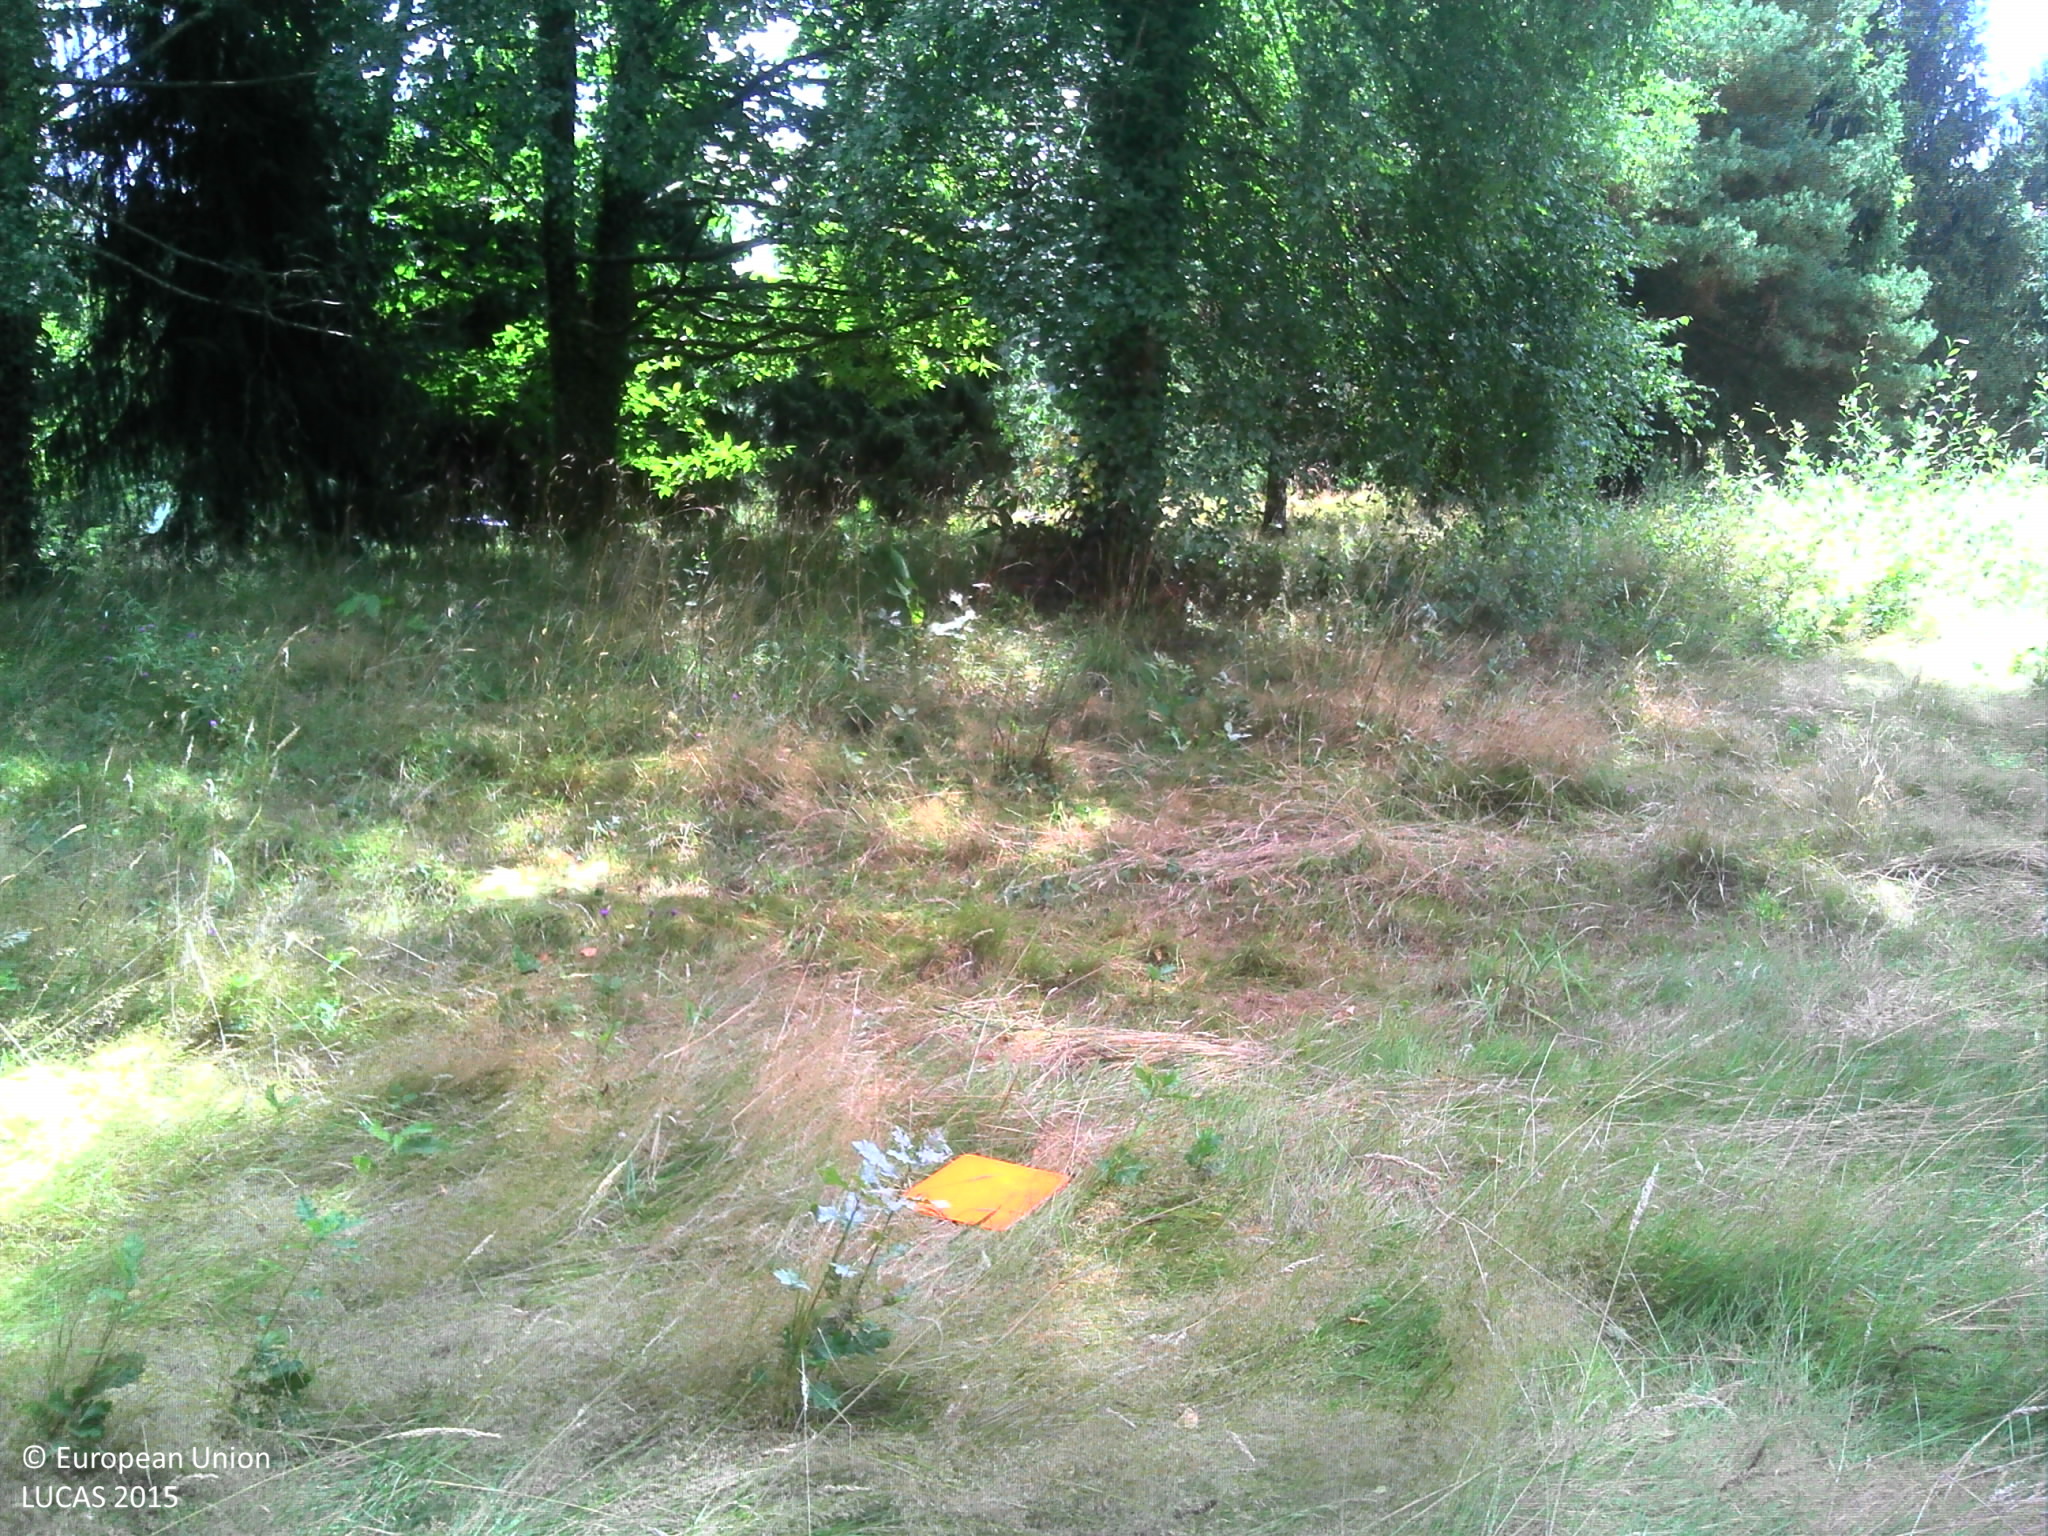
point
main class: Grassland
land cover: Grassland with sparse tree/shrub cover
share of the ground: > 75 %
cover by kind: herbaceous plants 85 %, shrubs 10 %, broadleaved forest trees 5 %
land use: Residential
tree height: > 5 m
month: August
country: FR
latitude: 46.7233
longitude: -1.3812
